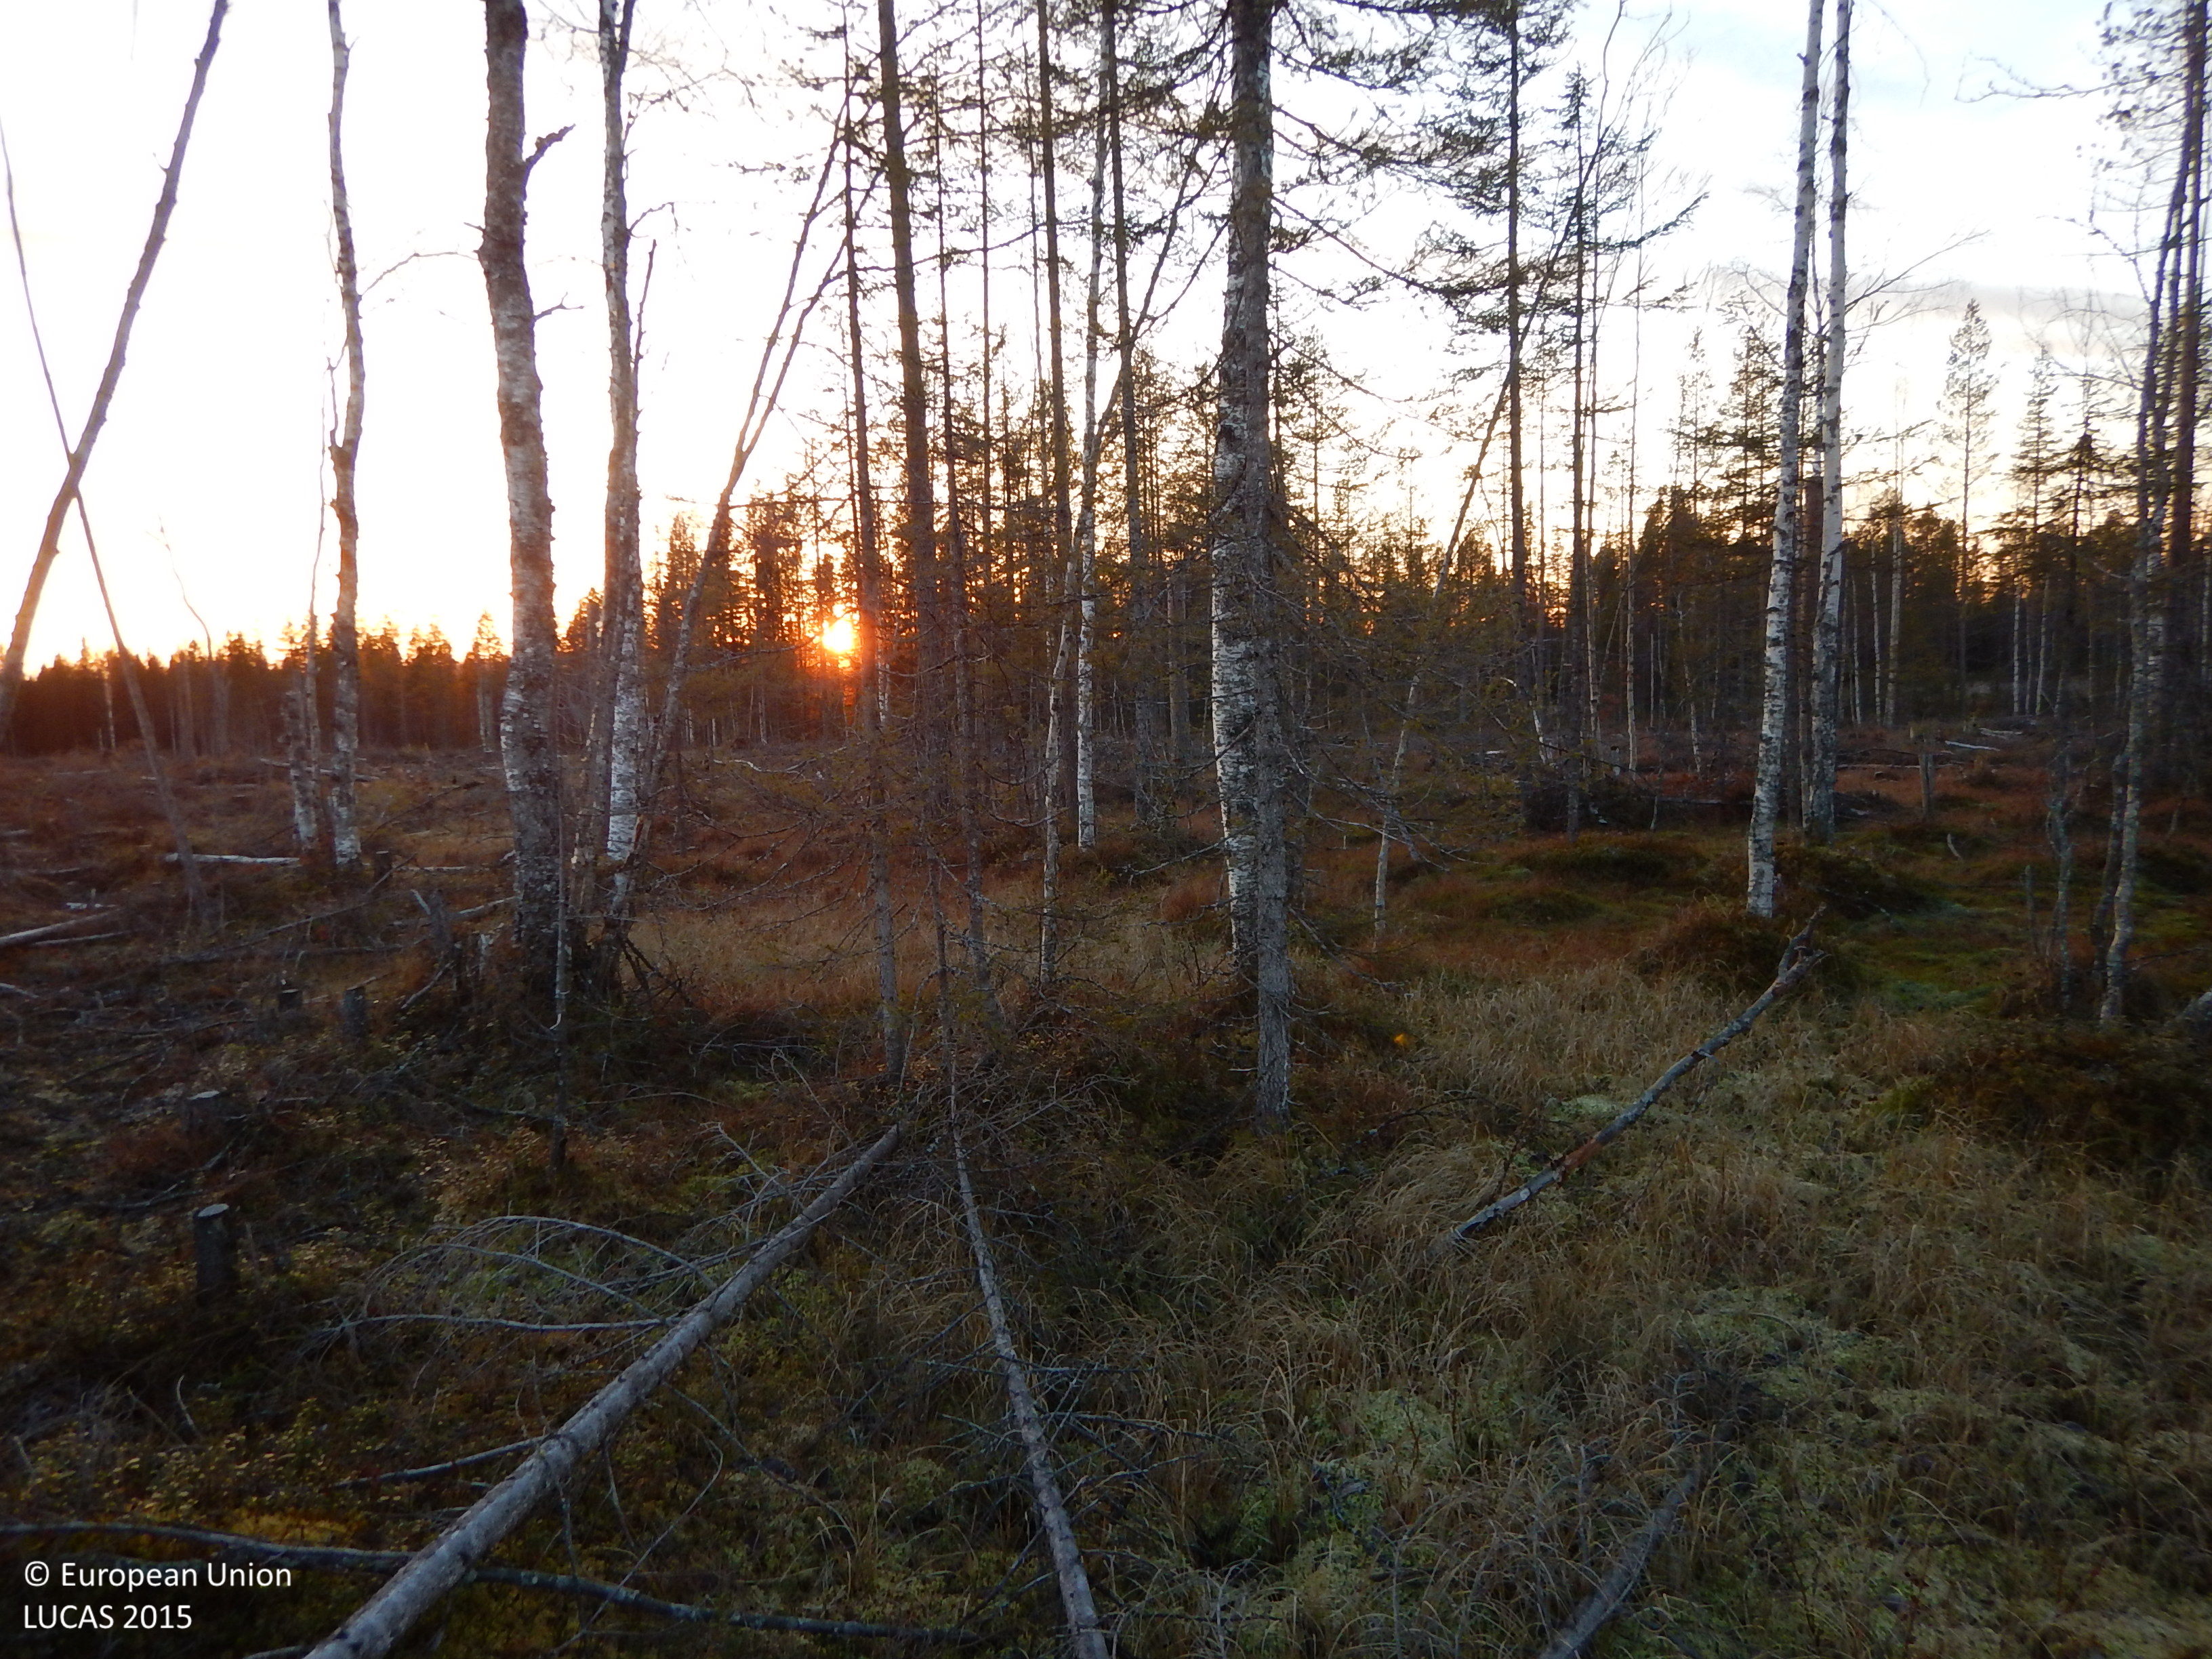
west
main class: Shrubland
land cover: Shrubland with sparse tree cover
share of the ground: 25 - 50 %
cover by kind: shrubs 40 %, herbaceous plants 25 %, lichens and mosses 20 %, coniferous forest trees 5 %
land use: Forestry
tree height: > 5 m
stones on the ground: < 10 %
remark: Clear cut
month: November
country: SE
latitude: 65.2115
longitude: 20.5944
